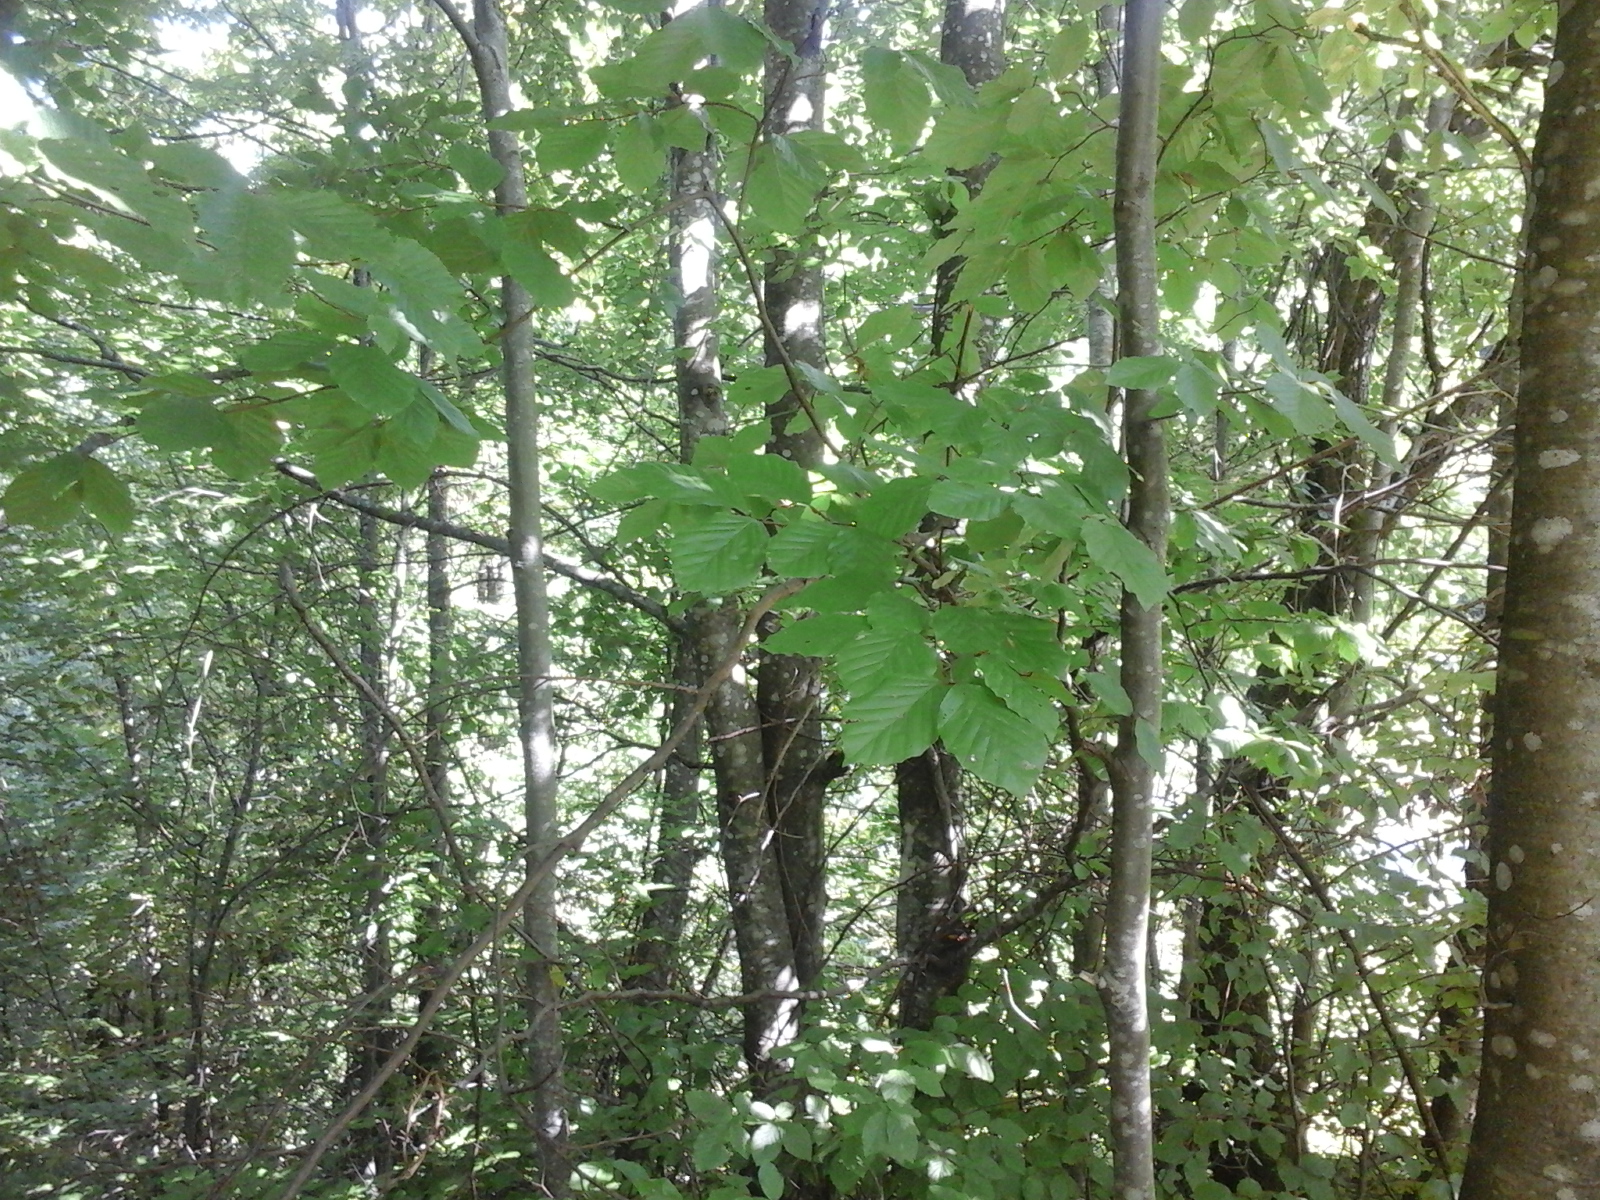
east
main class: Woodland
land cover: Broadleaved woodland
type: beech forest
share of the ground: > 75 %
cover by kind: broadleaved forest trees 100 %
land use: Forestry
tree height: > 5 m
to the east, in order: Broadleaved woodland; Electric lines; Grass margins; Paved roads, cycling and walking lanes; Broadleaved woodland
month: September
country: RO
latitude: 46.5986
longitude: 22.6513
